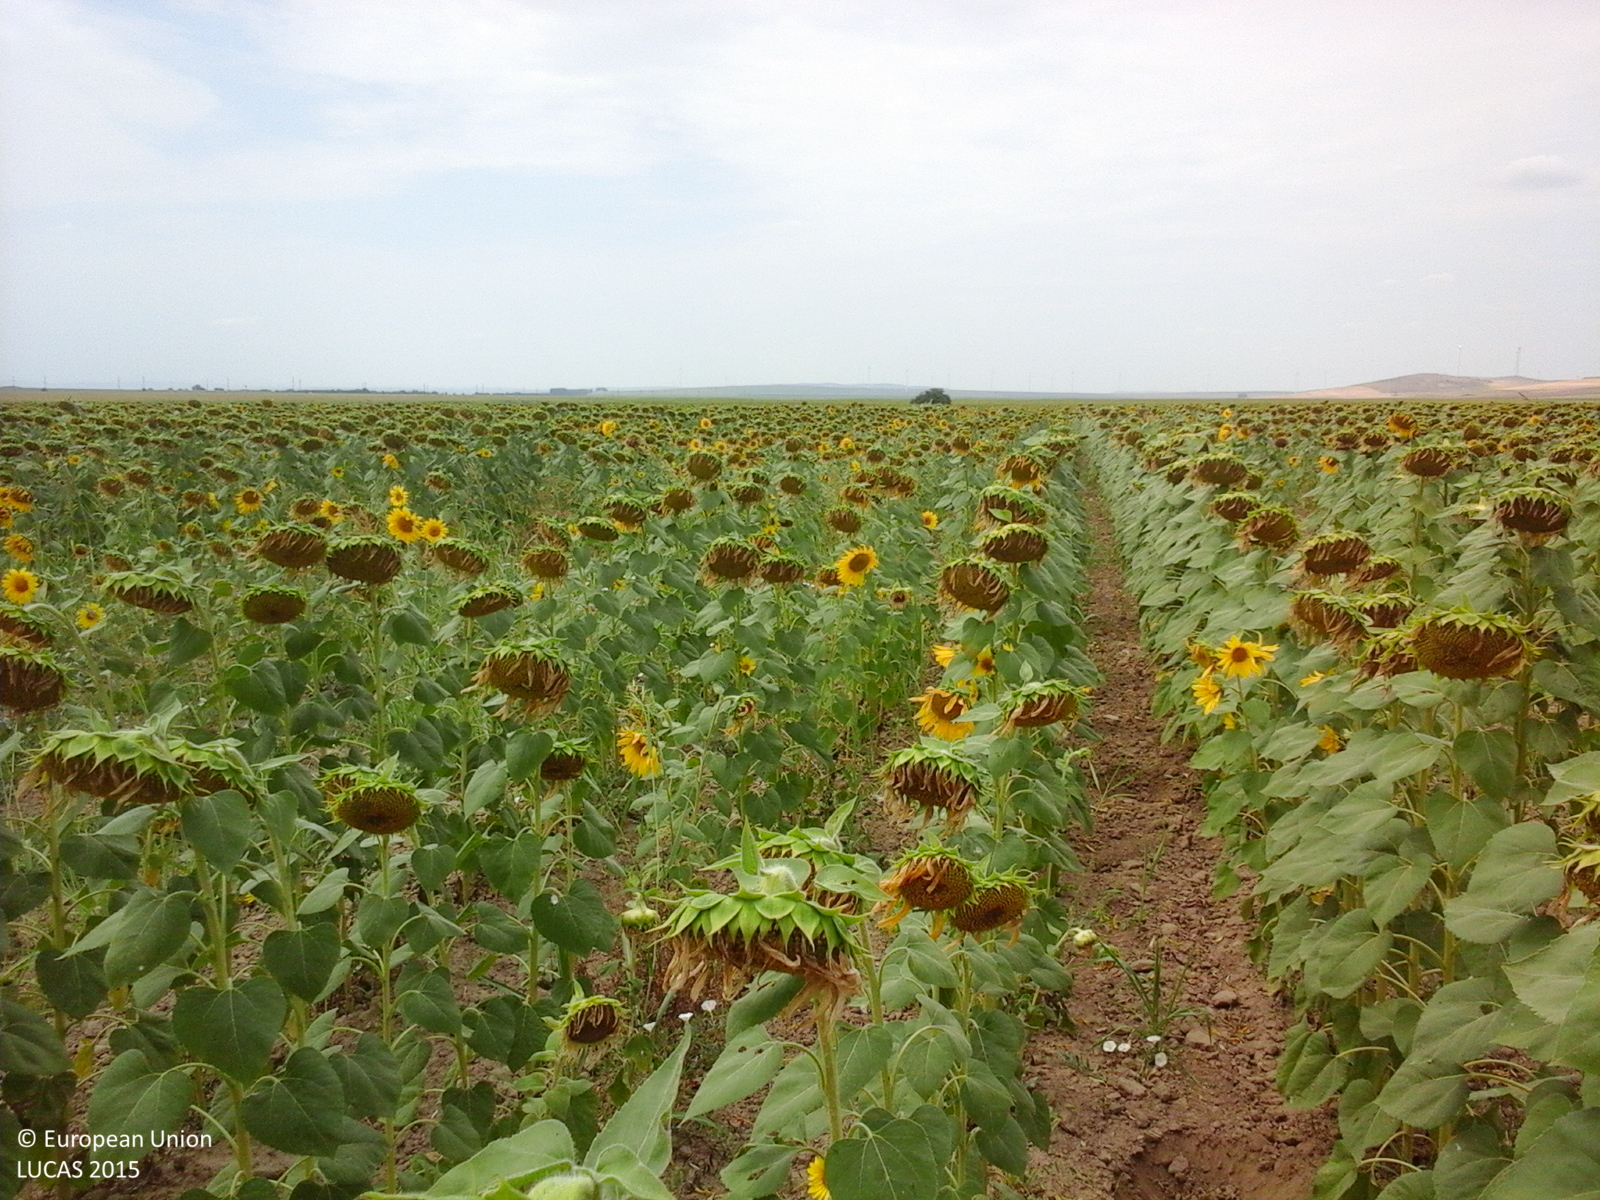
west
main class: Cropland
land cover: Sunflower
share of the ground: > 75 %
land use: Agriculture (excluding fallow land and kitchen gardens)
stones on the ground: < 10 %
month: August
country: RO
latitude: 45.0386
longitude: 29.0764
